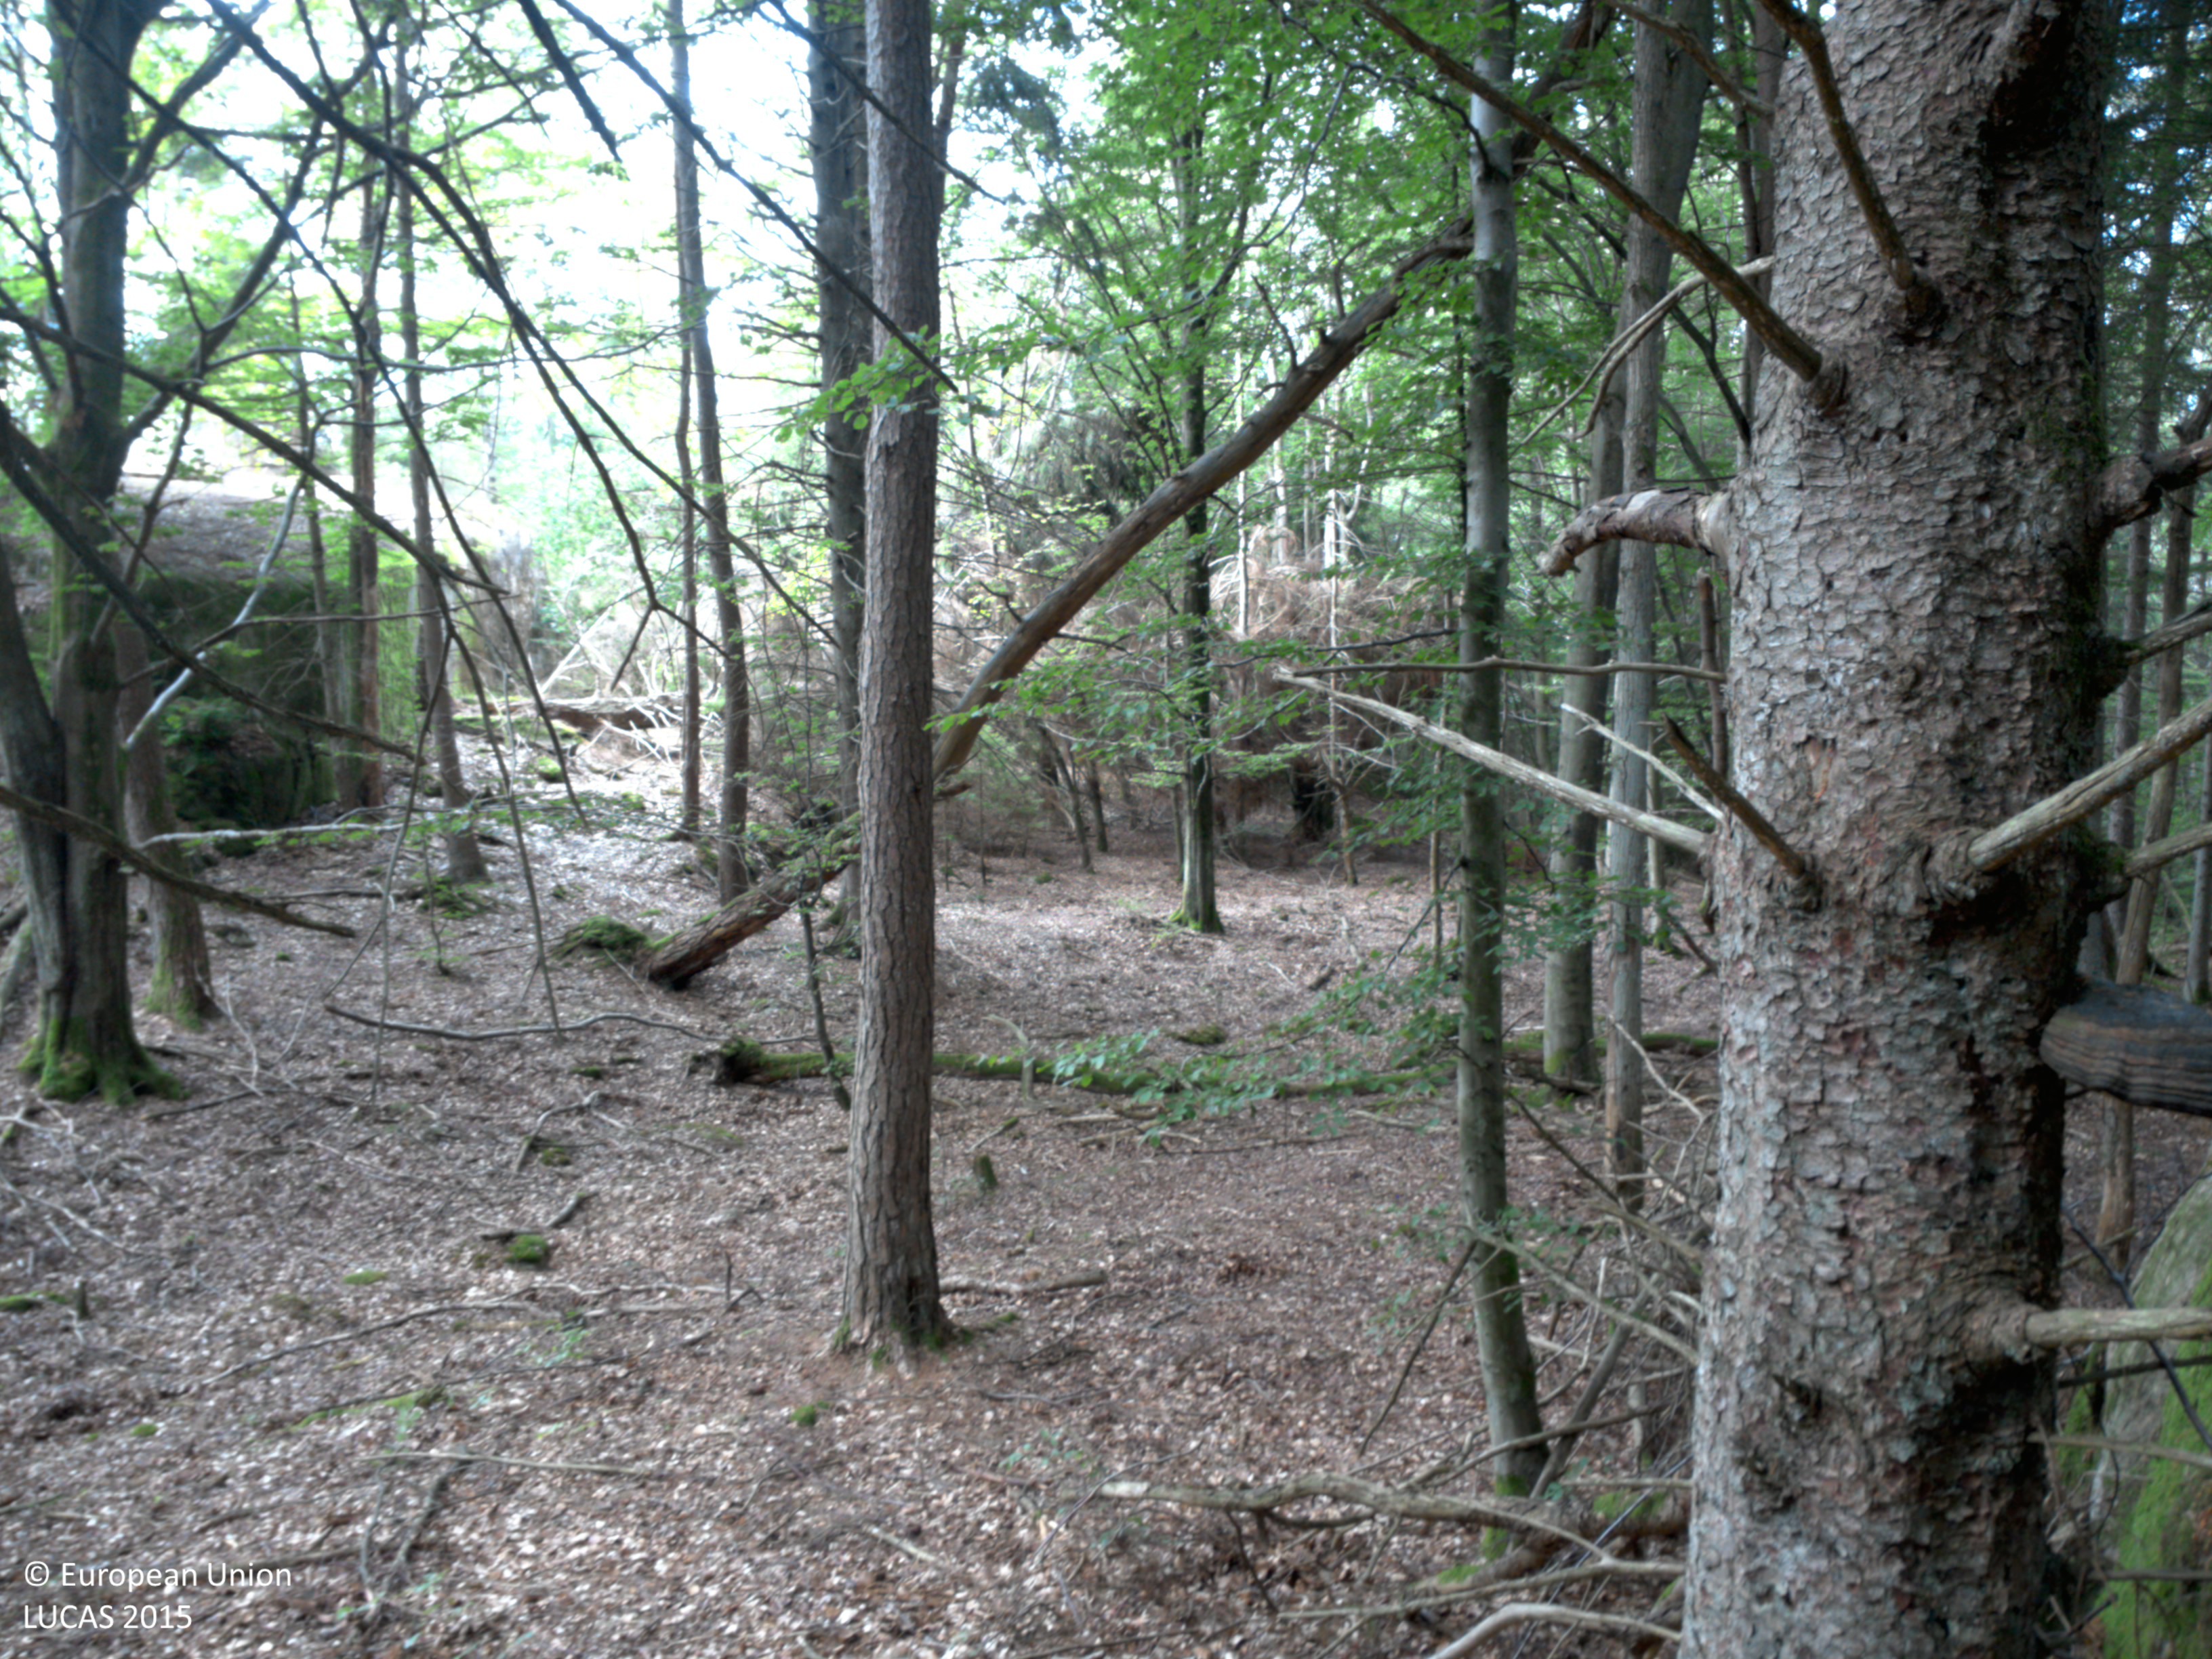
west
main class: Woodland
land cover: Spruce dominated mixed woodland
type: boreal forest
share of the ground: 50 - 75 %
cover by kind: unconsolidated bare surface 40 %, broadleaved forest trees 35 %, coniferous forest trees 20 %, shrubs 5 %
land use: Forestry
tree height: > 5 m
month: August
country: SE
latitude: 57.8652
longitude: 11.8340
